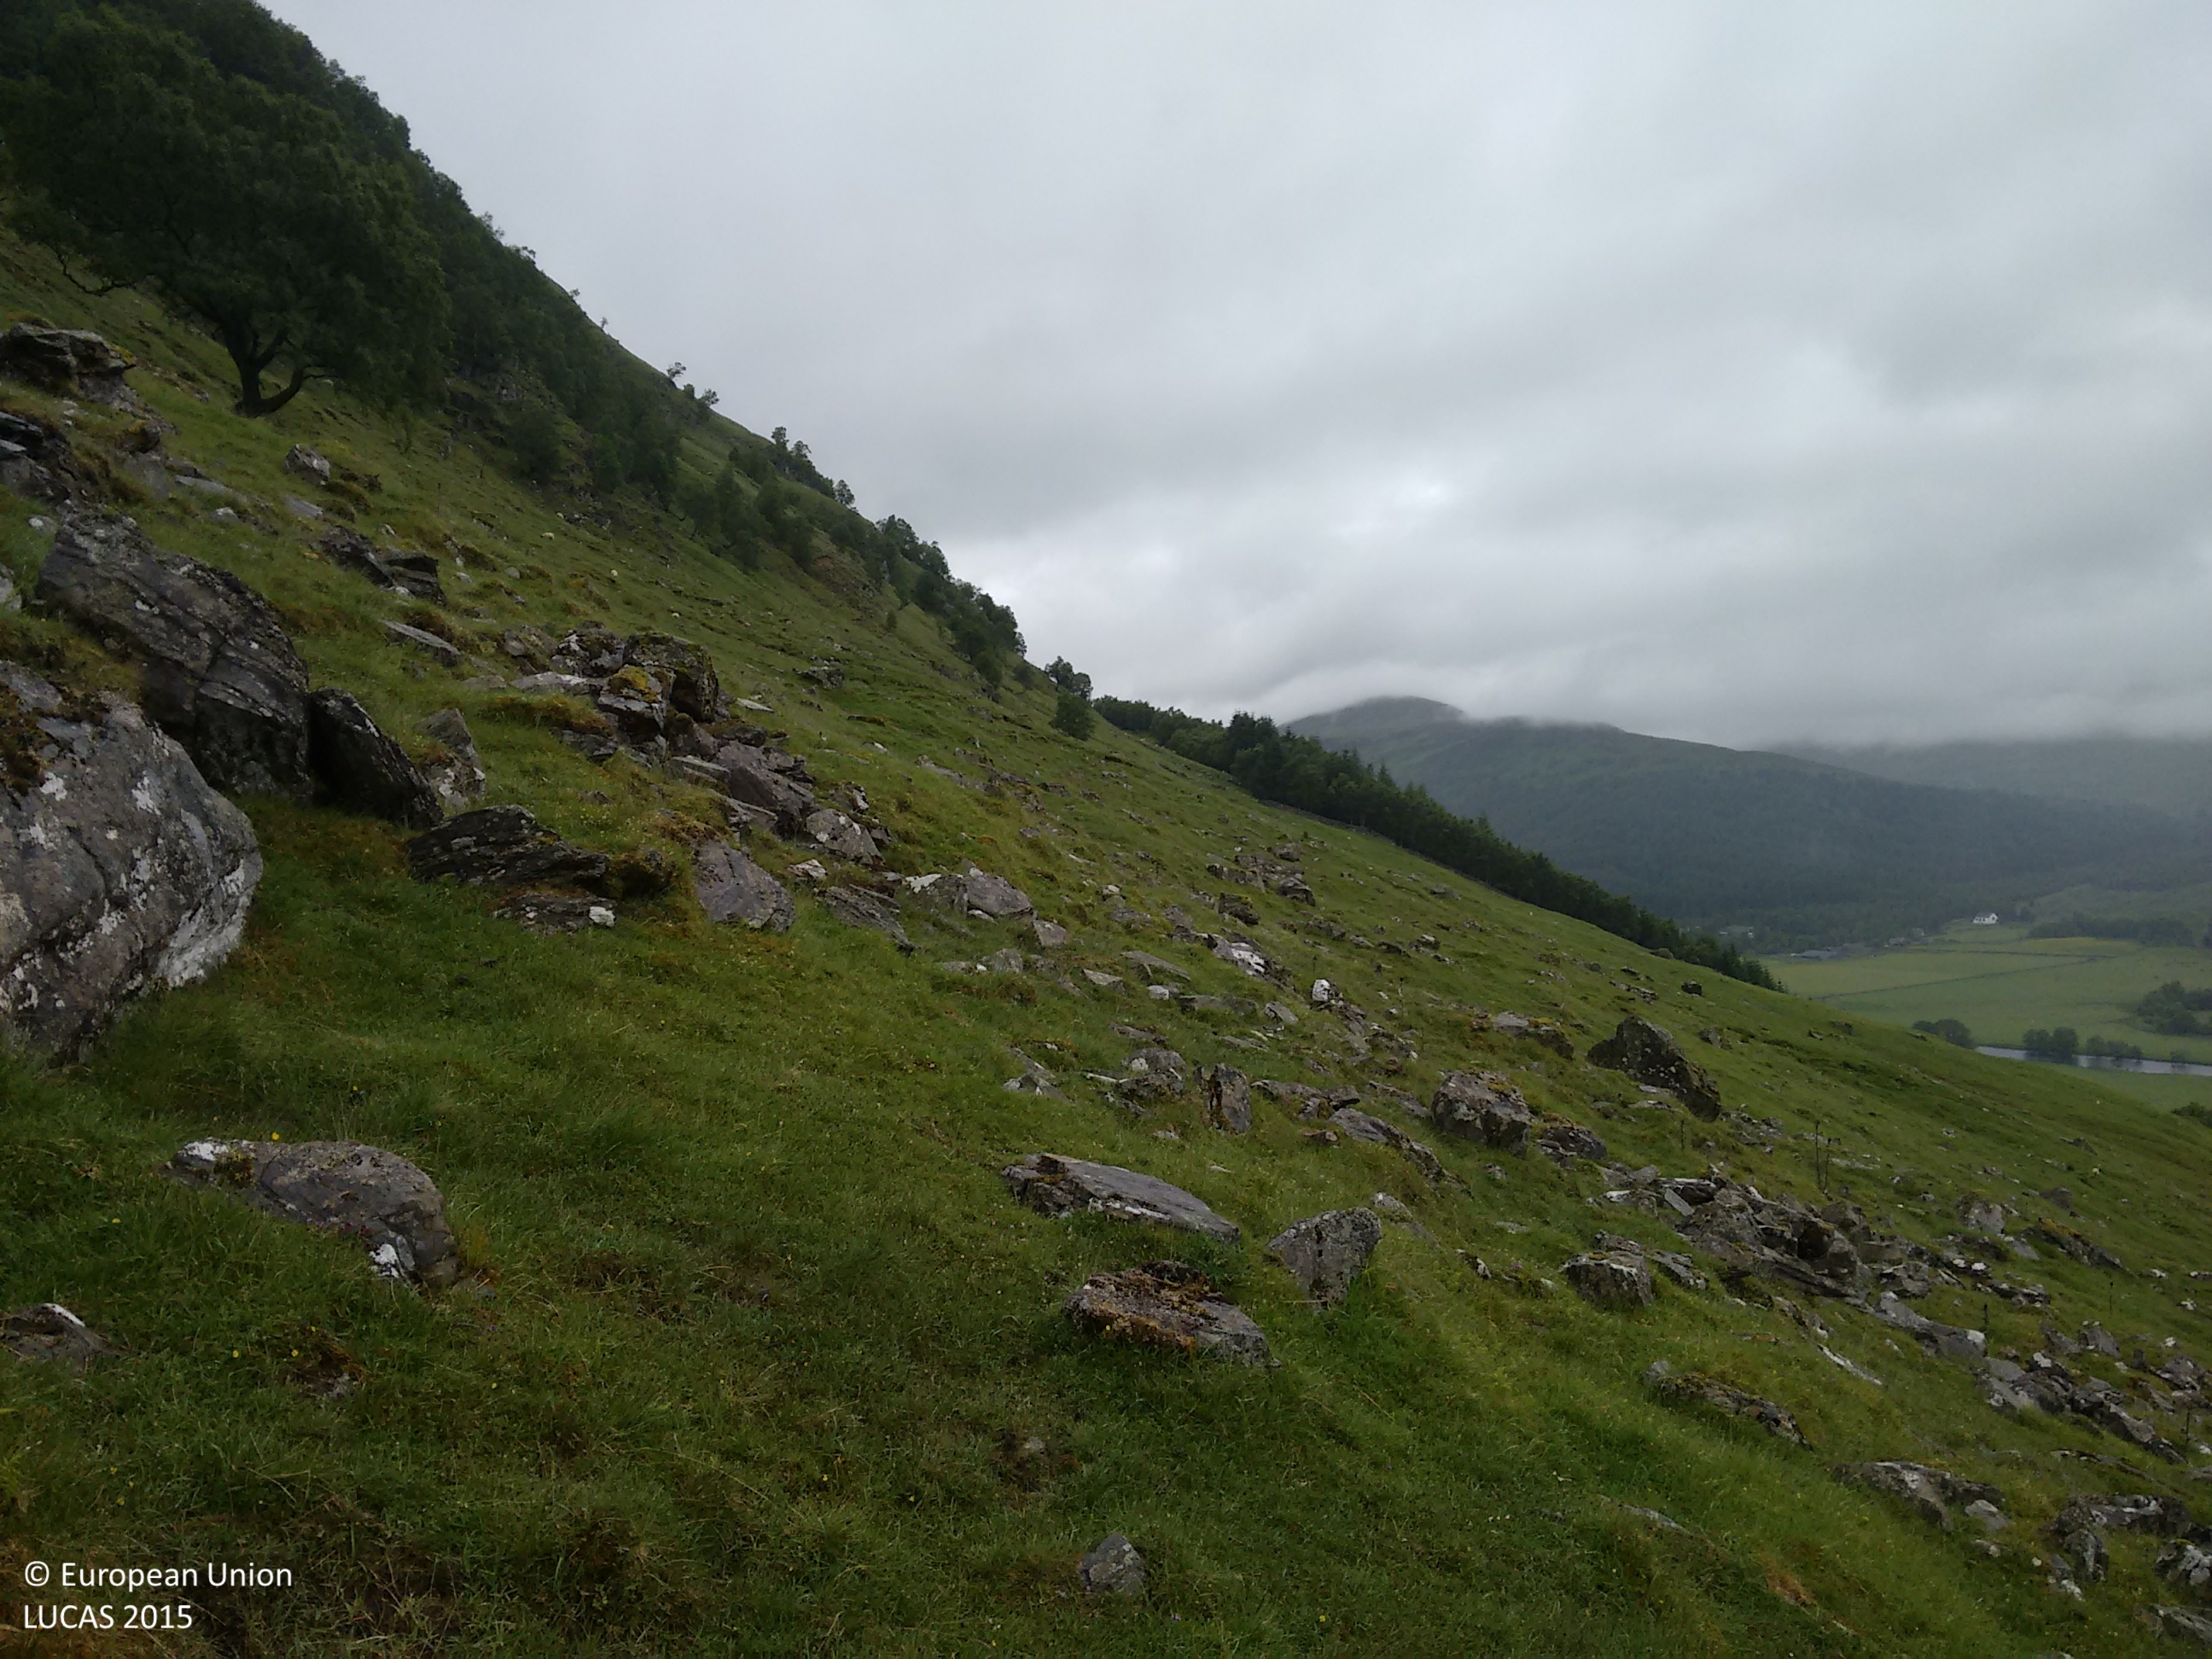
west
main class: Grassland
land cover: Grassland without tree/shrub cover
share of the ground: > 75 %
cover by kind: herbaceous plants 90 %, lichens and mosses 10 %
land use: Agriculture (excluding fallow land and kitchen gardens)
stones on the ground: < 10 %
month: July
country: GB
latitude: 56.5915
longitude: -4.2745
